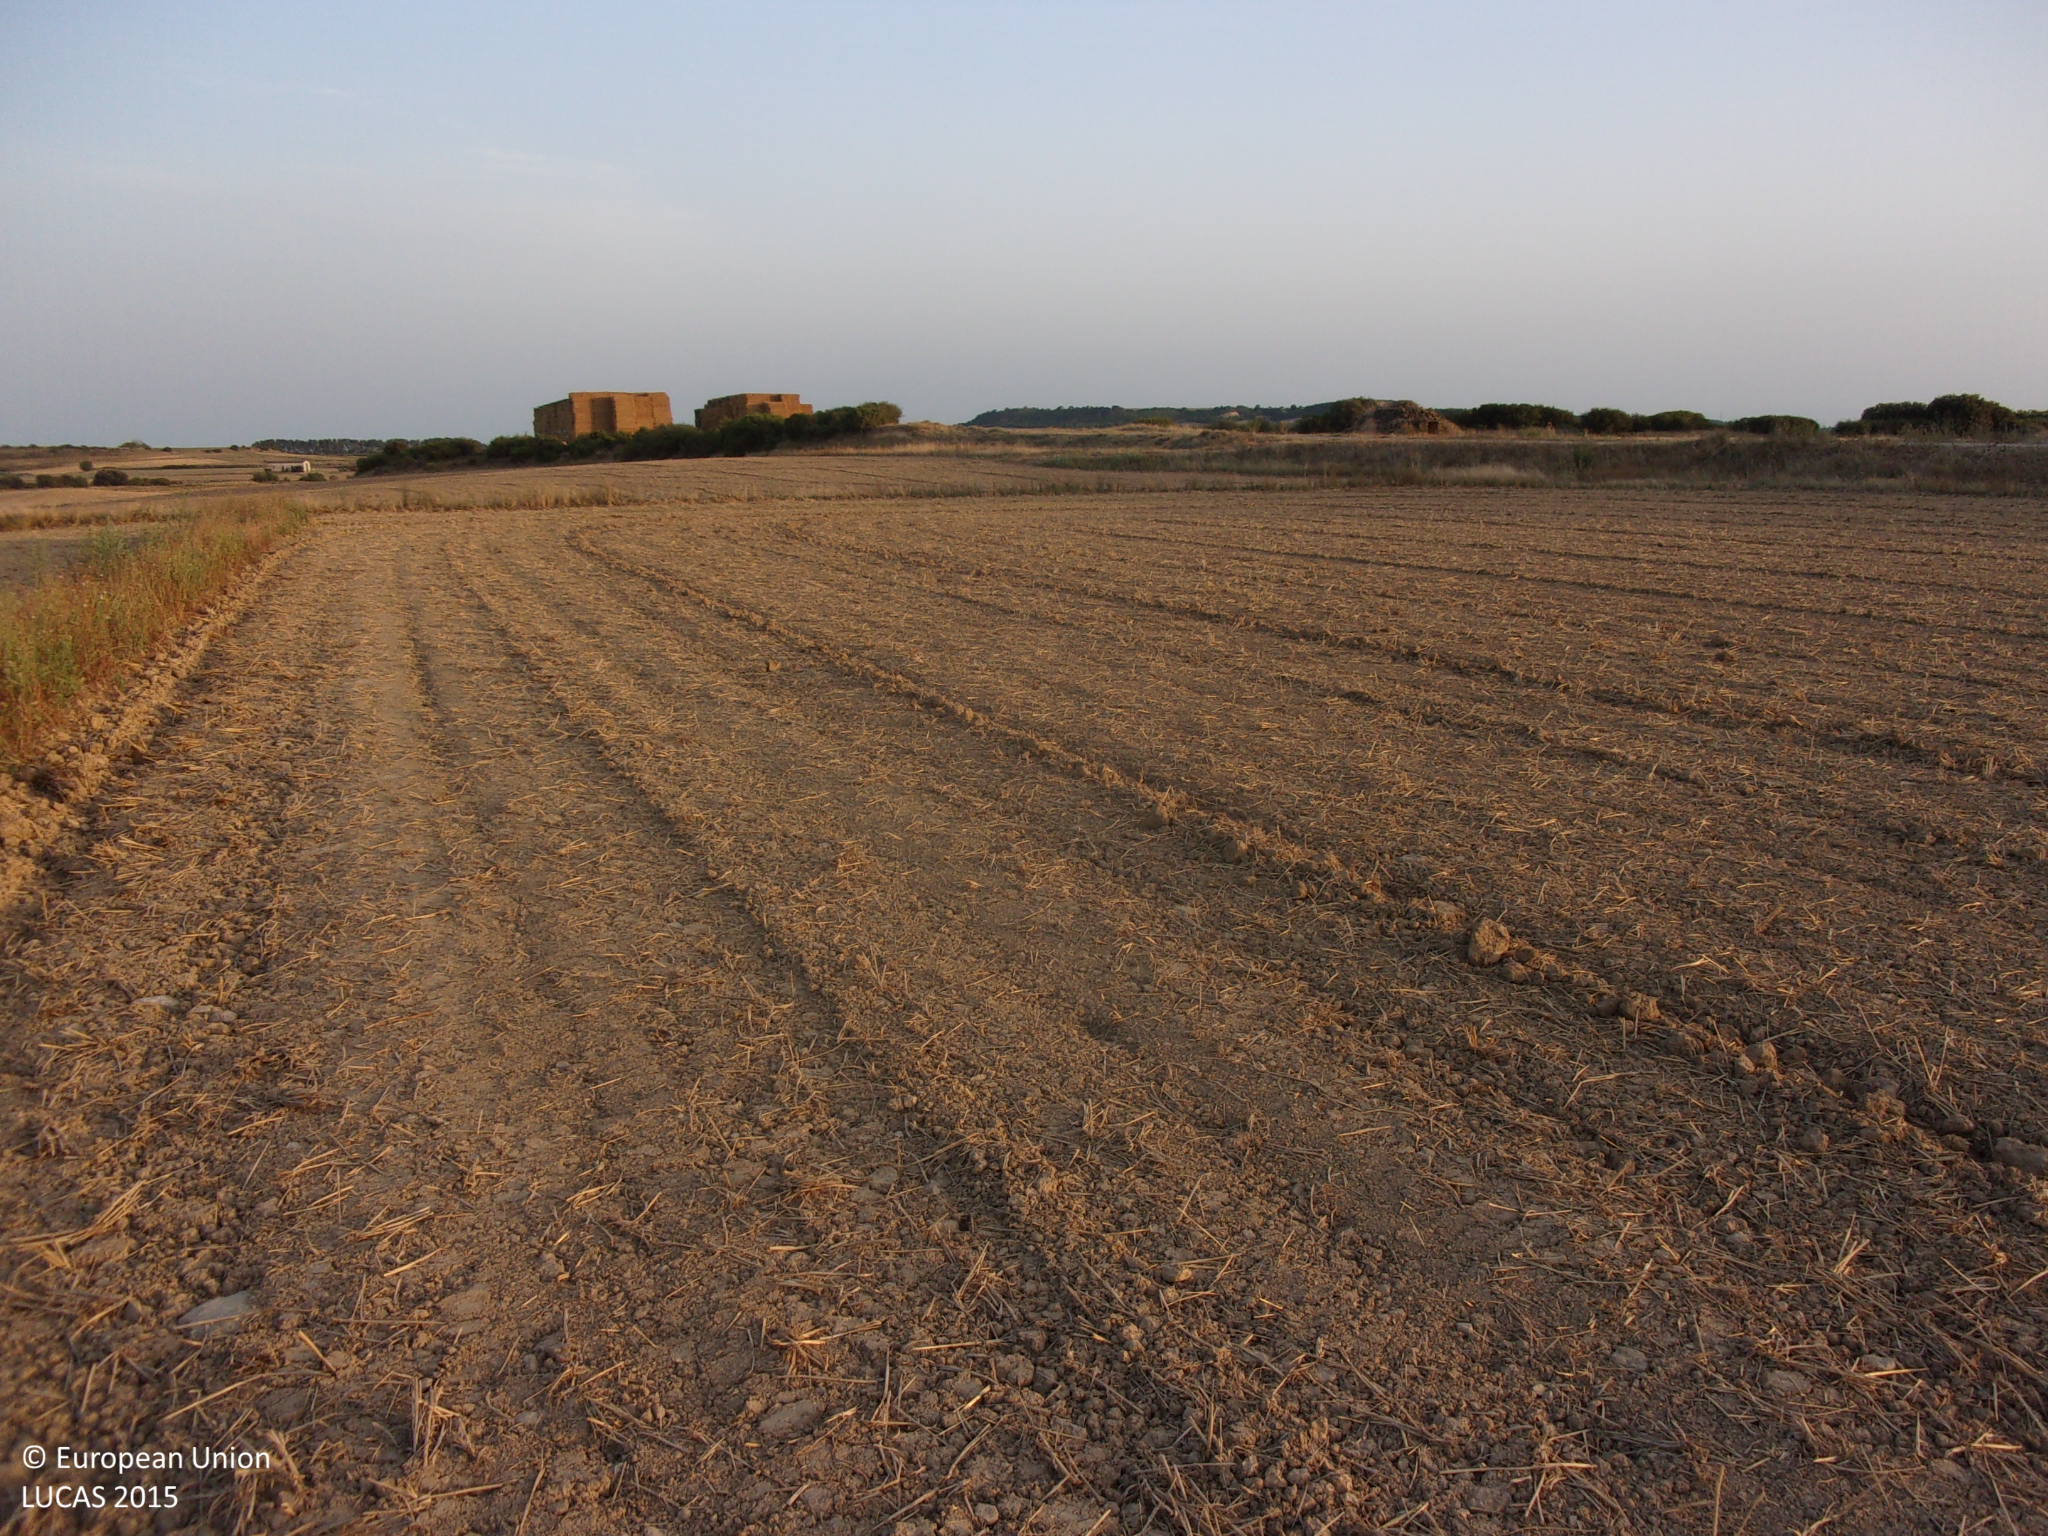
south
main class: Cropland
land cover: Common wheat
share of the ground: < 10 %
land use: Agriculture (excluding fallow land and kitchen gardens)
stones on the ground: < 10 %
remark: Harvested field
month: August
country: ES
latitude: 42.4275
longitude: -1.3977
